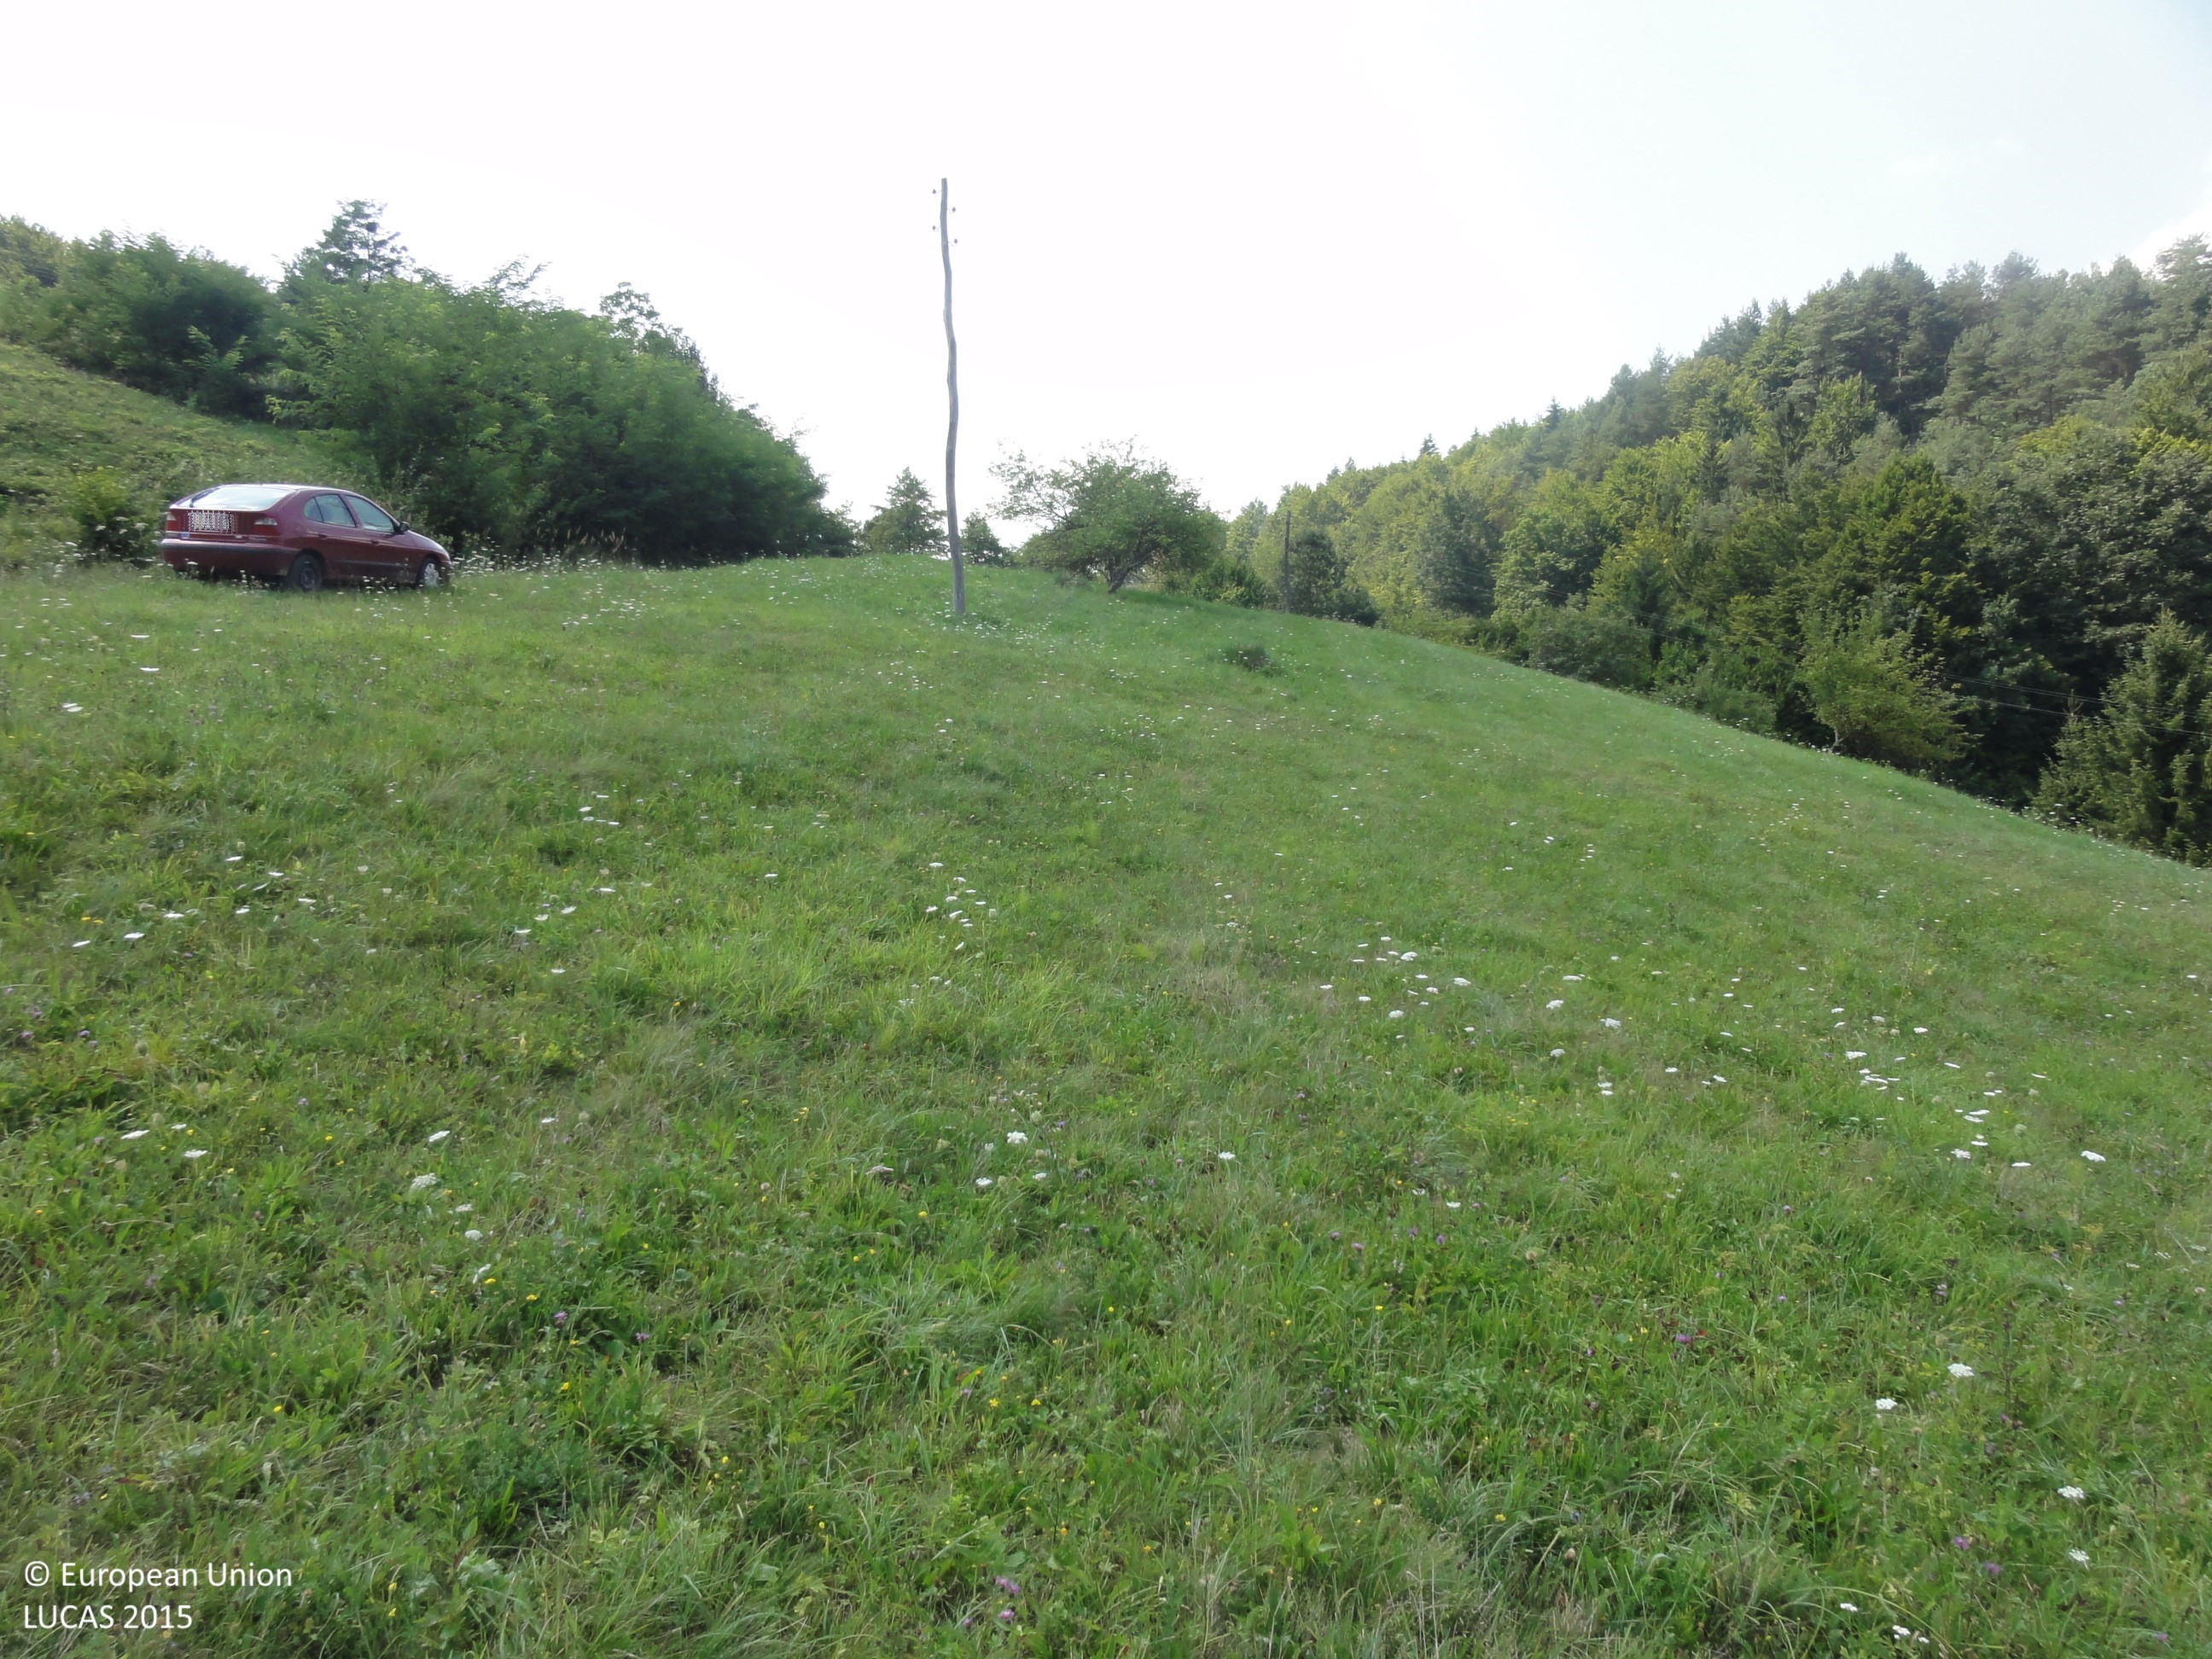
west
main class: Grassland
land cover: Grassland without tree/shrub cover
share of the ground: > 75 %
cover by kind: herbaceous plants 100 %
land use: Agriculture (excluding fallow land and kitchen gardens)
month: August
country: SI
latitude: 46.1375
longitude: 15.4992
